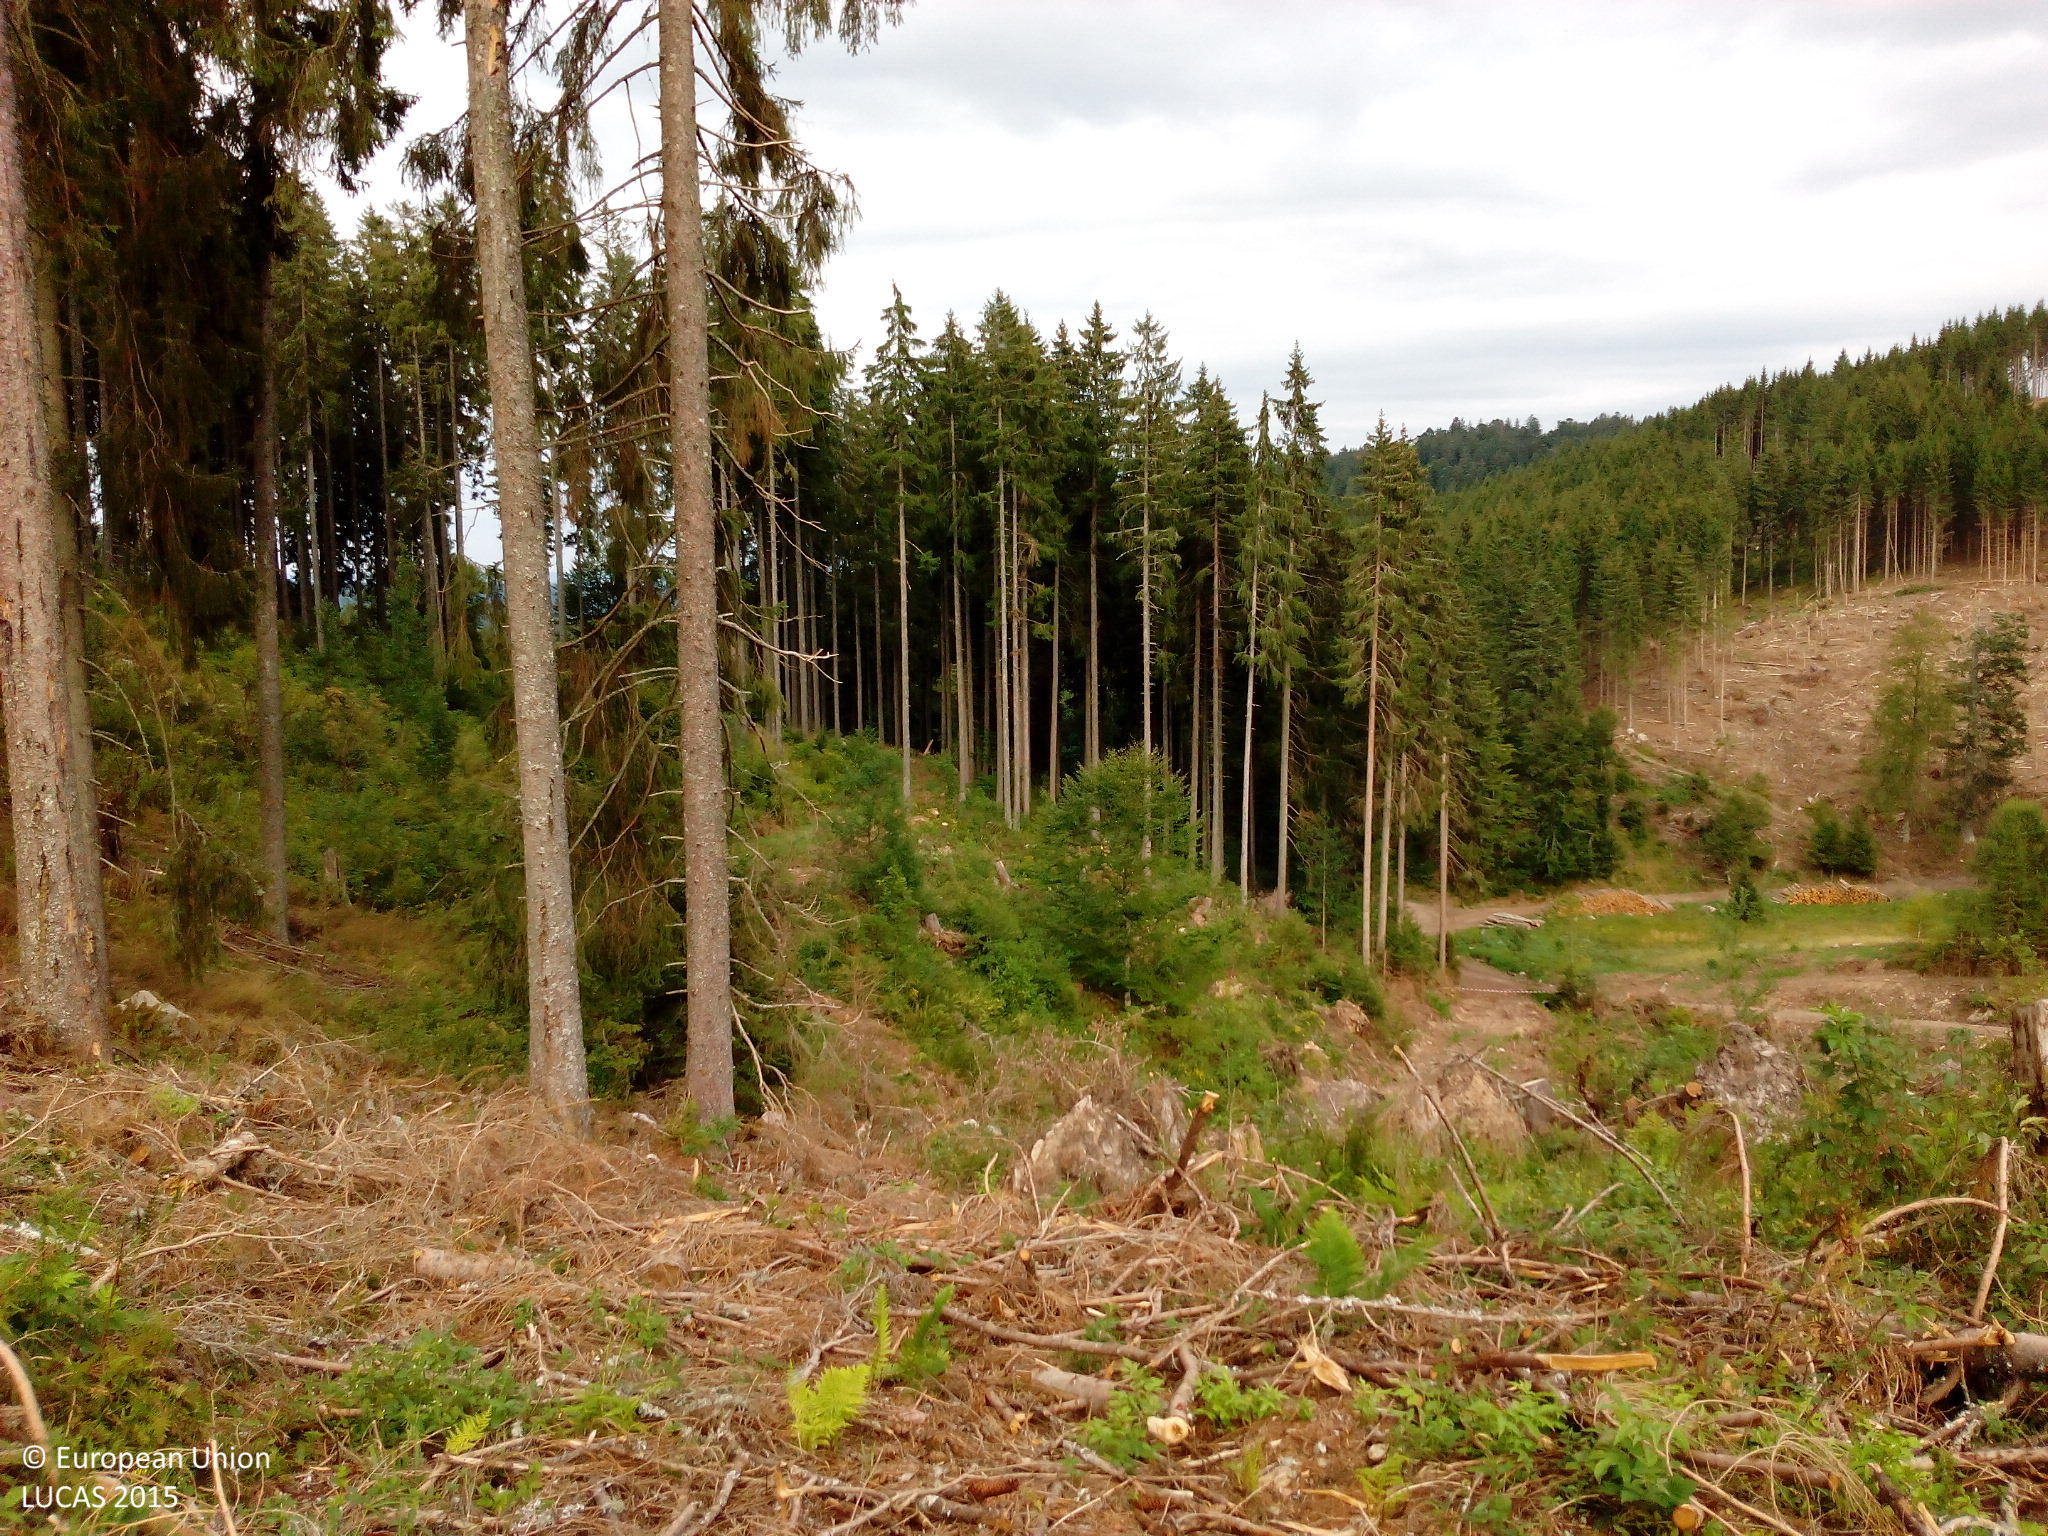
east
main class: Grassland
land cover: Spontaneously vegetated surfaces
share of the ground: 10 - 25 %
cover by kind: unconsolidated bare surface 75 %, herbaceous plants 15 %, shrubs 5 %
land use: Forestry
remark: Clear cut
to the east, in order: Spontaneously vegetated surfaces; Spruce dominated coniferous woodland; Spontaneously vegetated surfaces; Broadleaved woodland; Grassland with sparse tree/shrub cover; Spruce dominated coniferous woodland; Spontaneously vegetated surfaces; Rock outcrops; Tracks; Spruce dominated mixed woodland; Rivers and streams; Spruce dominated mixed woodland; Tracks
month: August
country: DE
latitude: 47.8488
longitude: 8.1971
